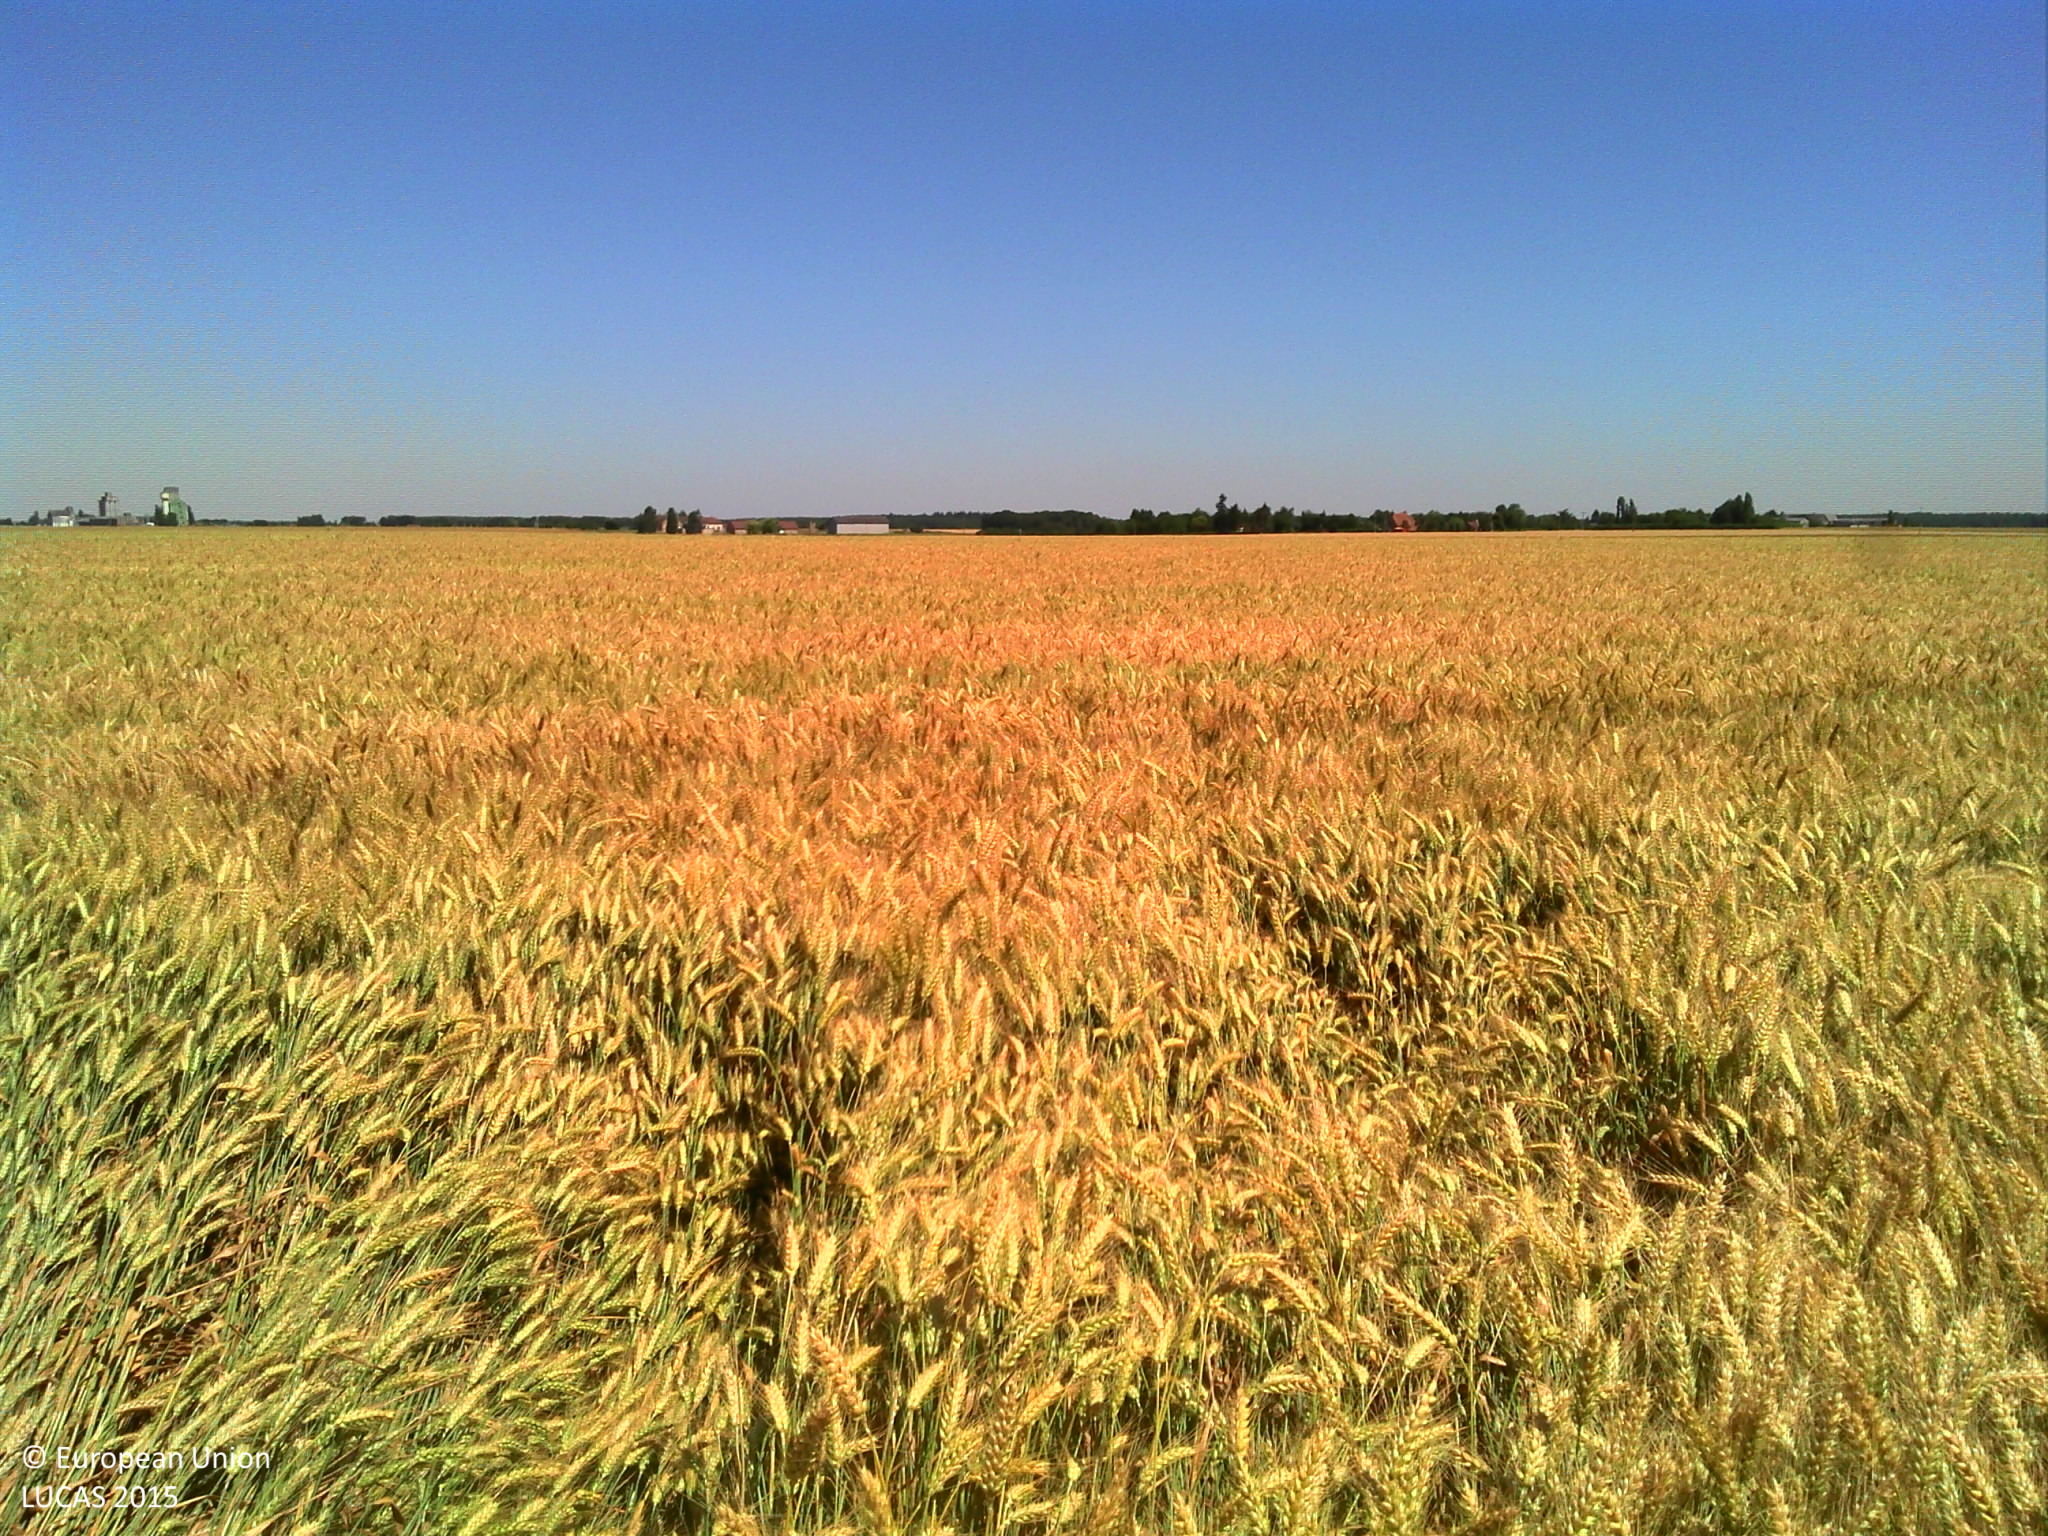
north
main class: Cropland
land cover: Common wheat
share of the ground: > 75 %
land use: Agriculture (excluding fallow land and kitchen gardens)
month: June
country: FR
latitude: 48.6849
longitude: 1.1922
